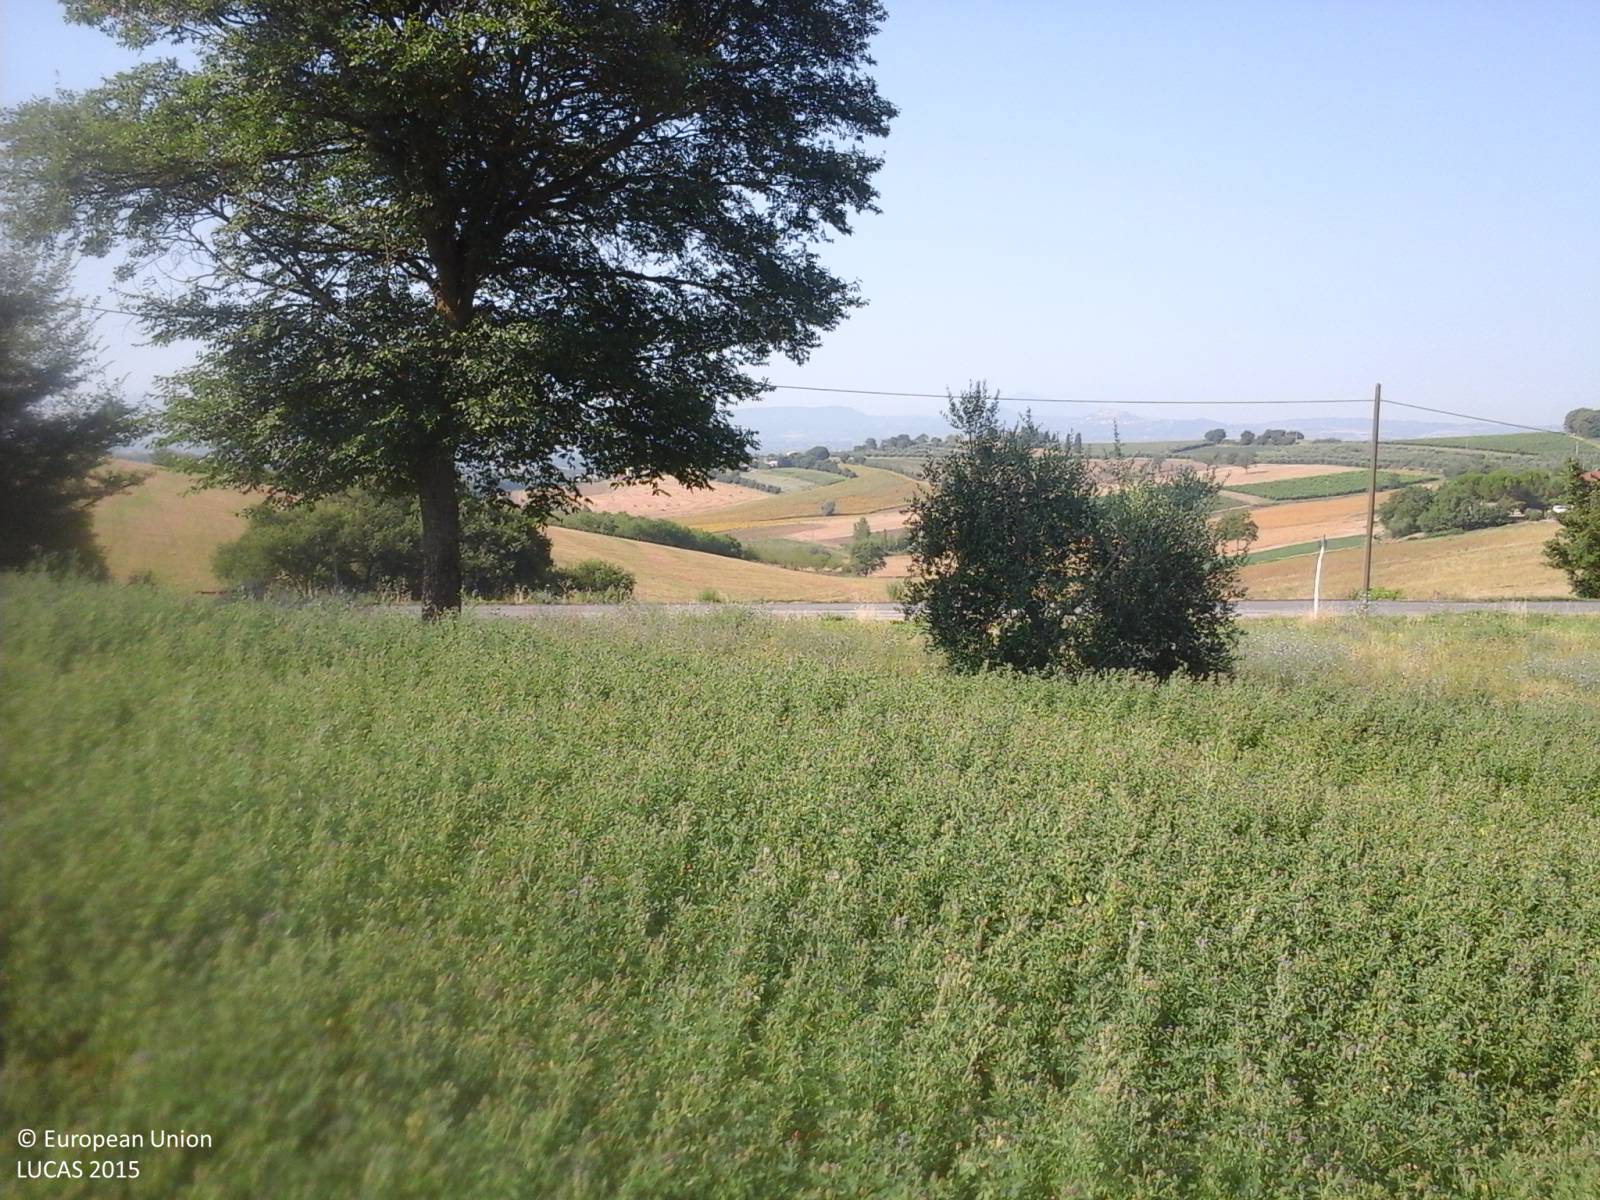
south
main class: Cropland
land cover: Lucerne
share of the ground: > 75 %
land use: Agriculture (excluding fallow land and kitchen gardens)
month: July
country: IT
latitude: 43.1965
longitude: 11.8773
